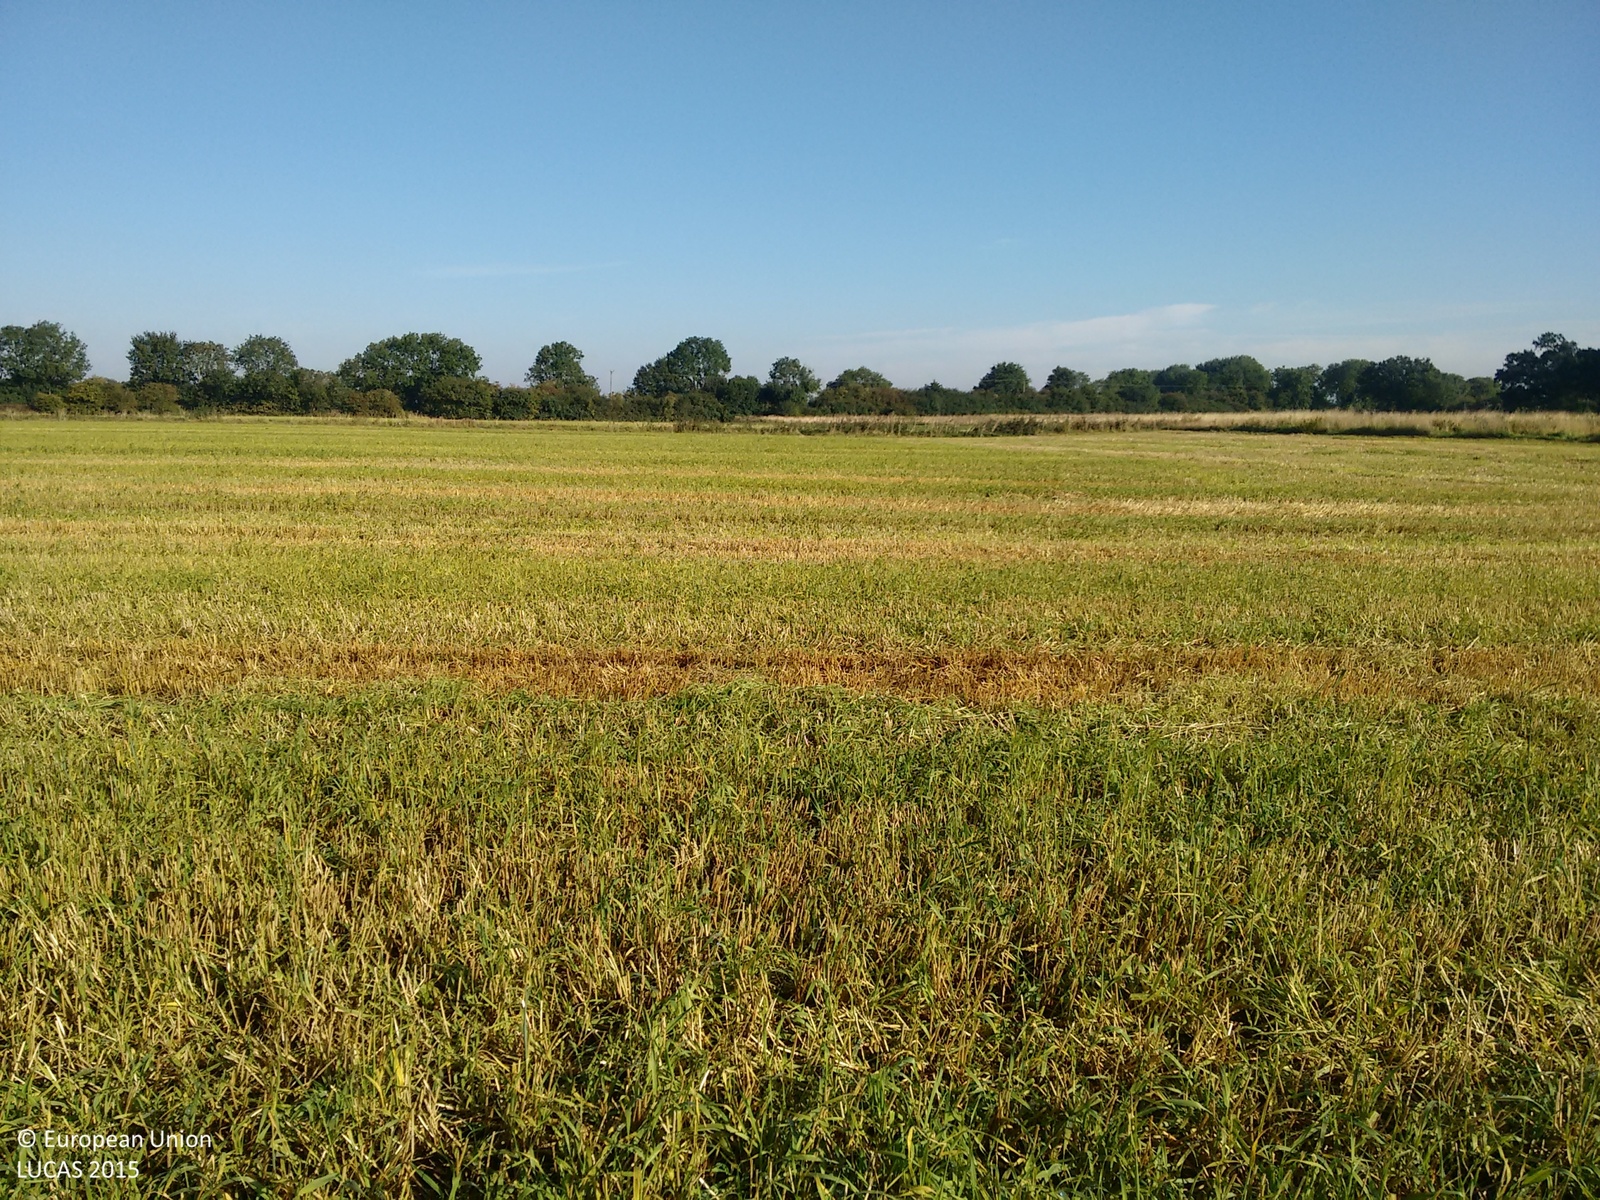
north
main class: Cropland
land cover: Barley
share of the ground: > 75 %
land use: Agriculture (excluding fallow land and kitchen gardens)
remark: Harvested field
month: September
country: GB
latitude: 52.2251
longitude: 0.2049
